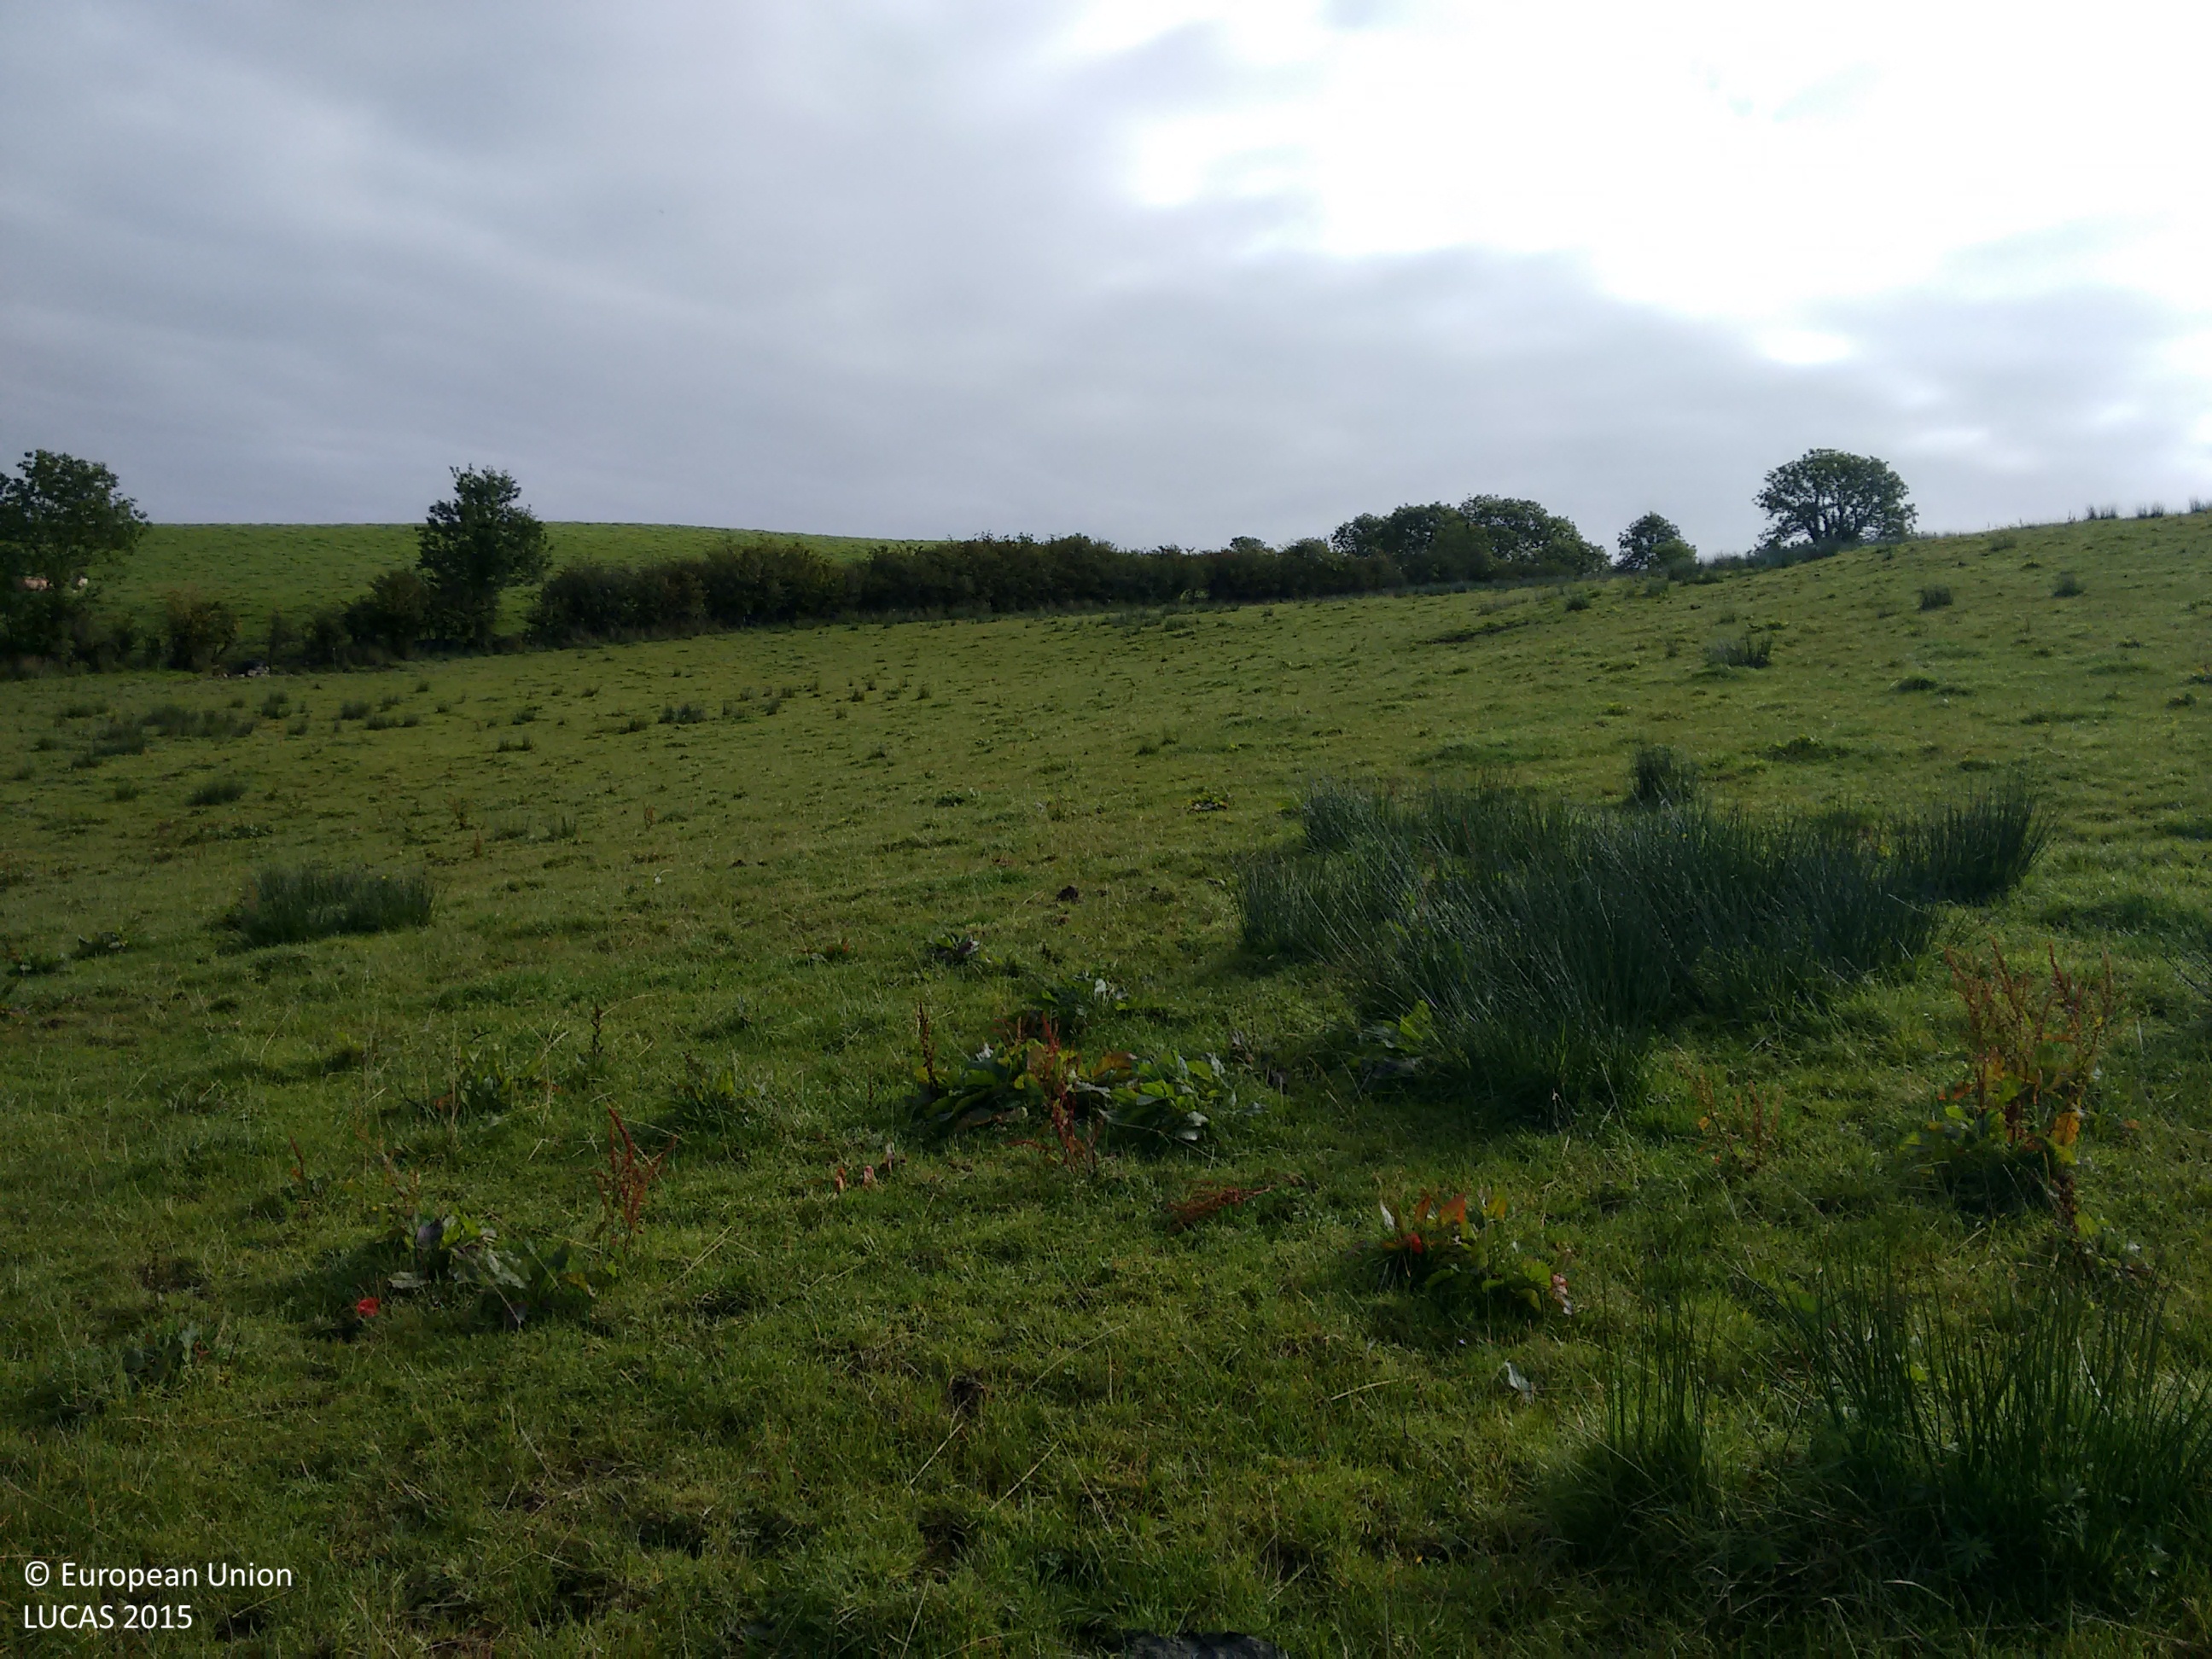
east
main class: Grassland
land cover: Grassland without tree/shrub cover
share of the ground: > 75 %
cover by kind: herbaceous plants 100 %
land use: Agriculture (excluding fallow land and kitchen gardens)
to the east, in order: Grassland without tree/shrub cover; Fences; Managed hedges; Grassland without tree/shrub cover; Fences; Grassland without tree/shrub cover
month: September
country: IE
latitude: 54.1340
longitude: -6.8961
